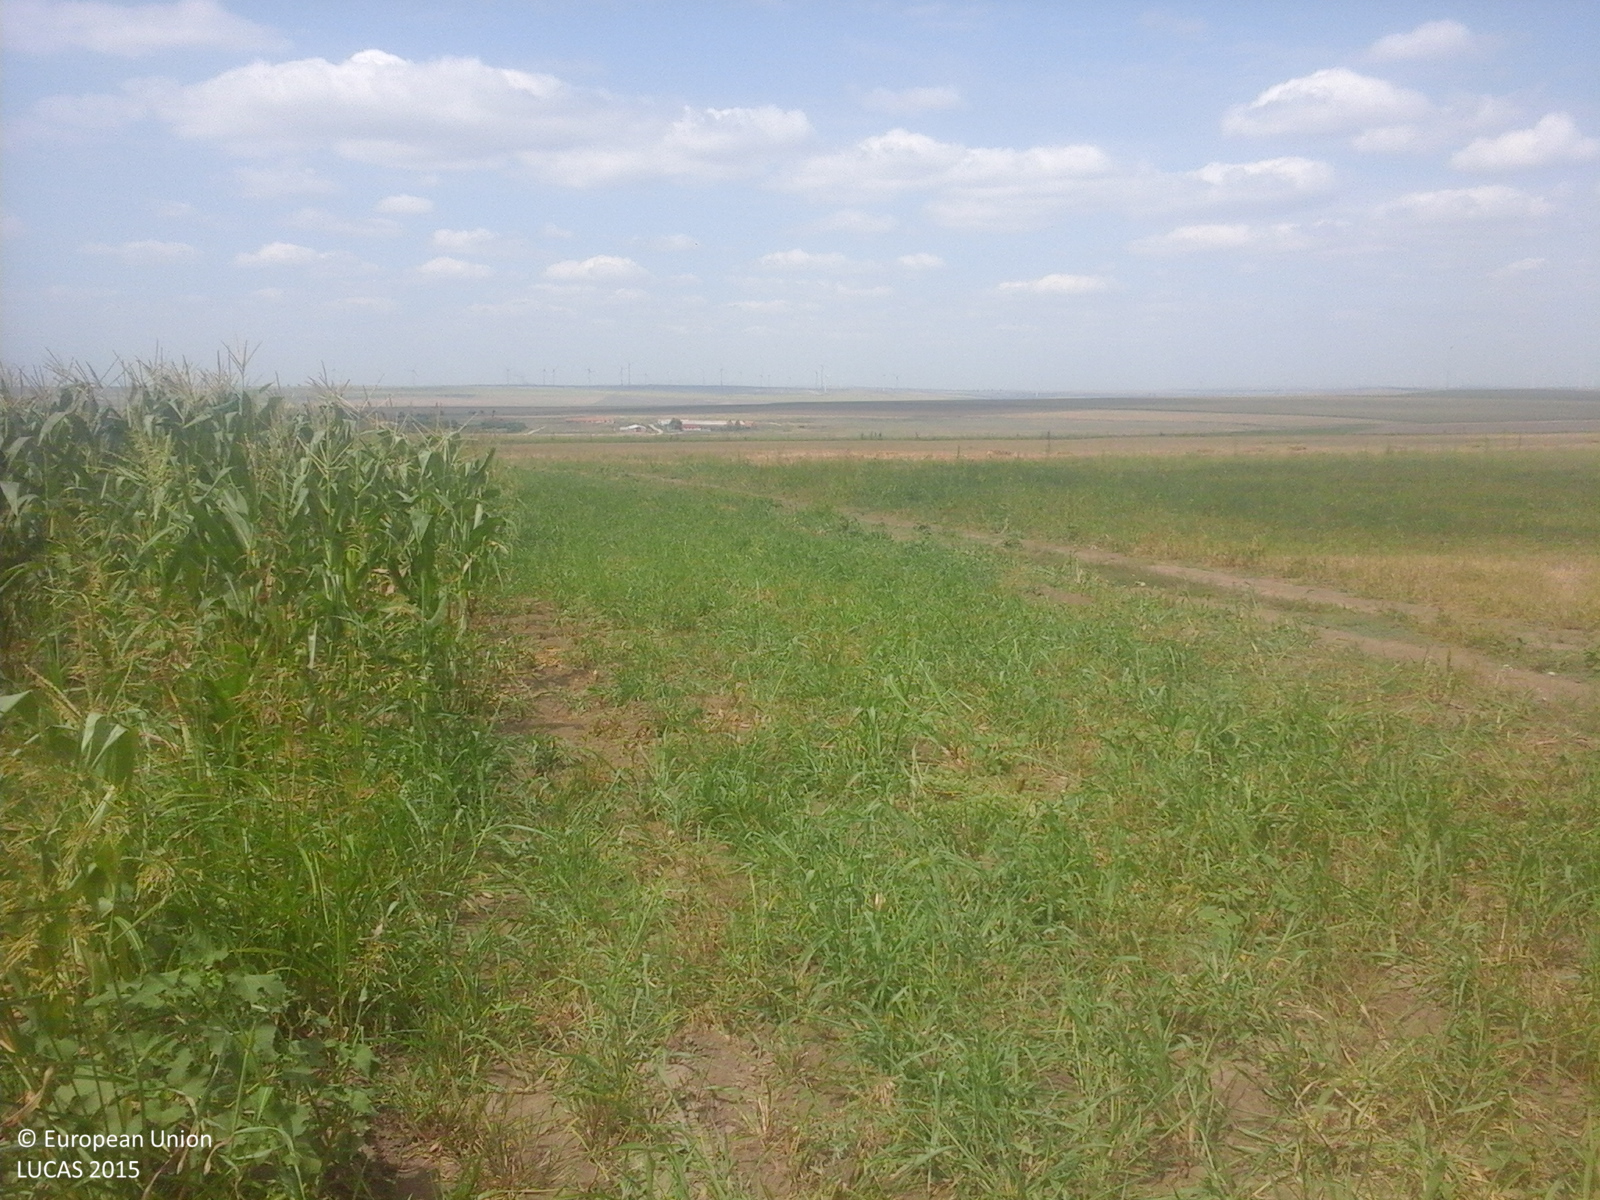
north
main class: Cropland
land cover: Maize
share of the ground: > 75 %
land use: Agriculture (excluding fallow land and kitchen gardens)
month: August
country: RO
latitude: 44.6900
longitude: 28.2495
